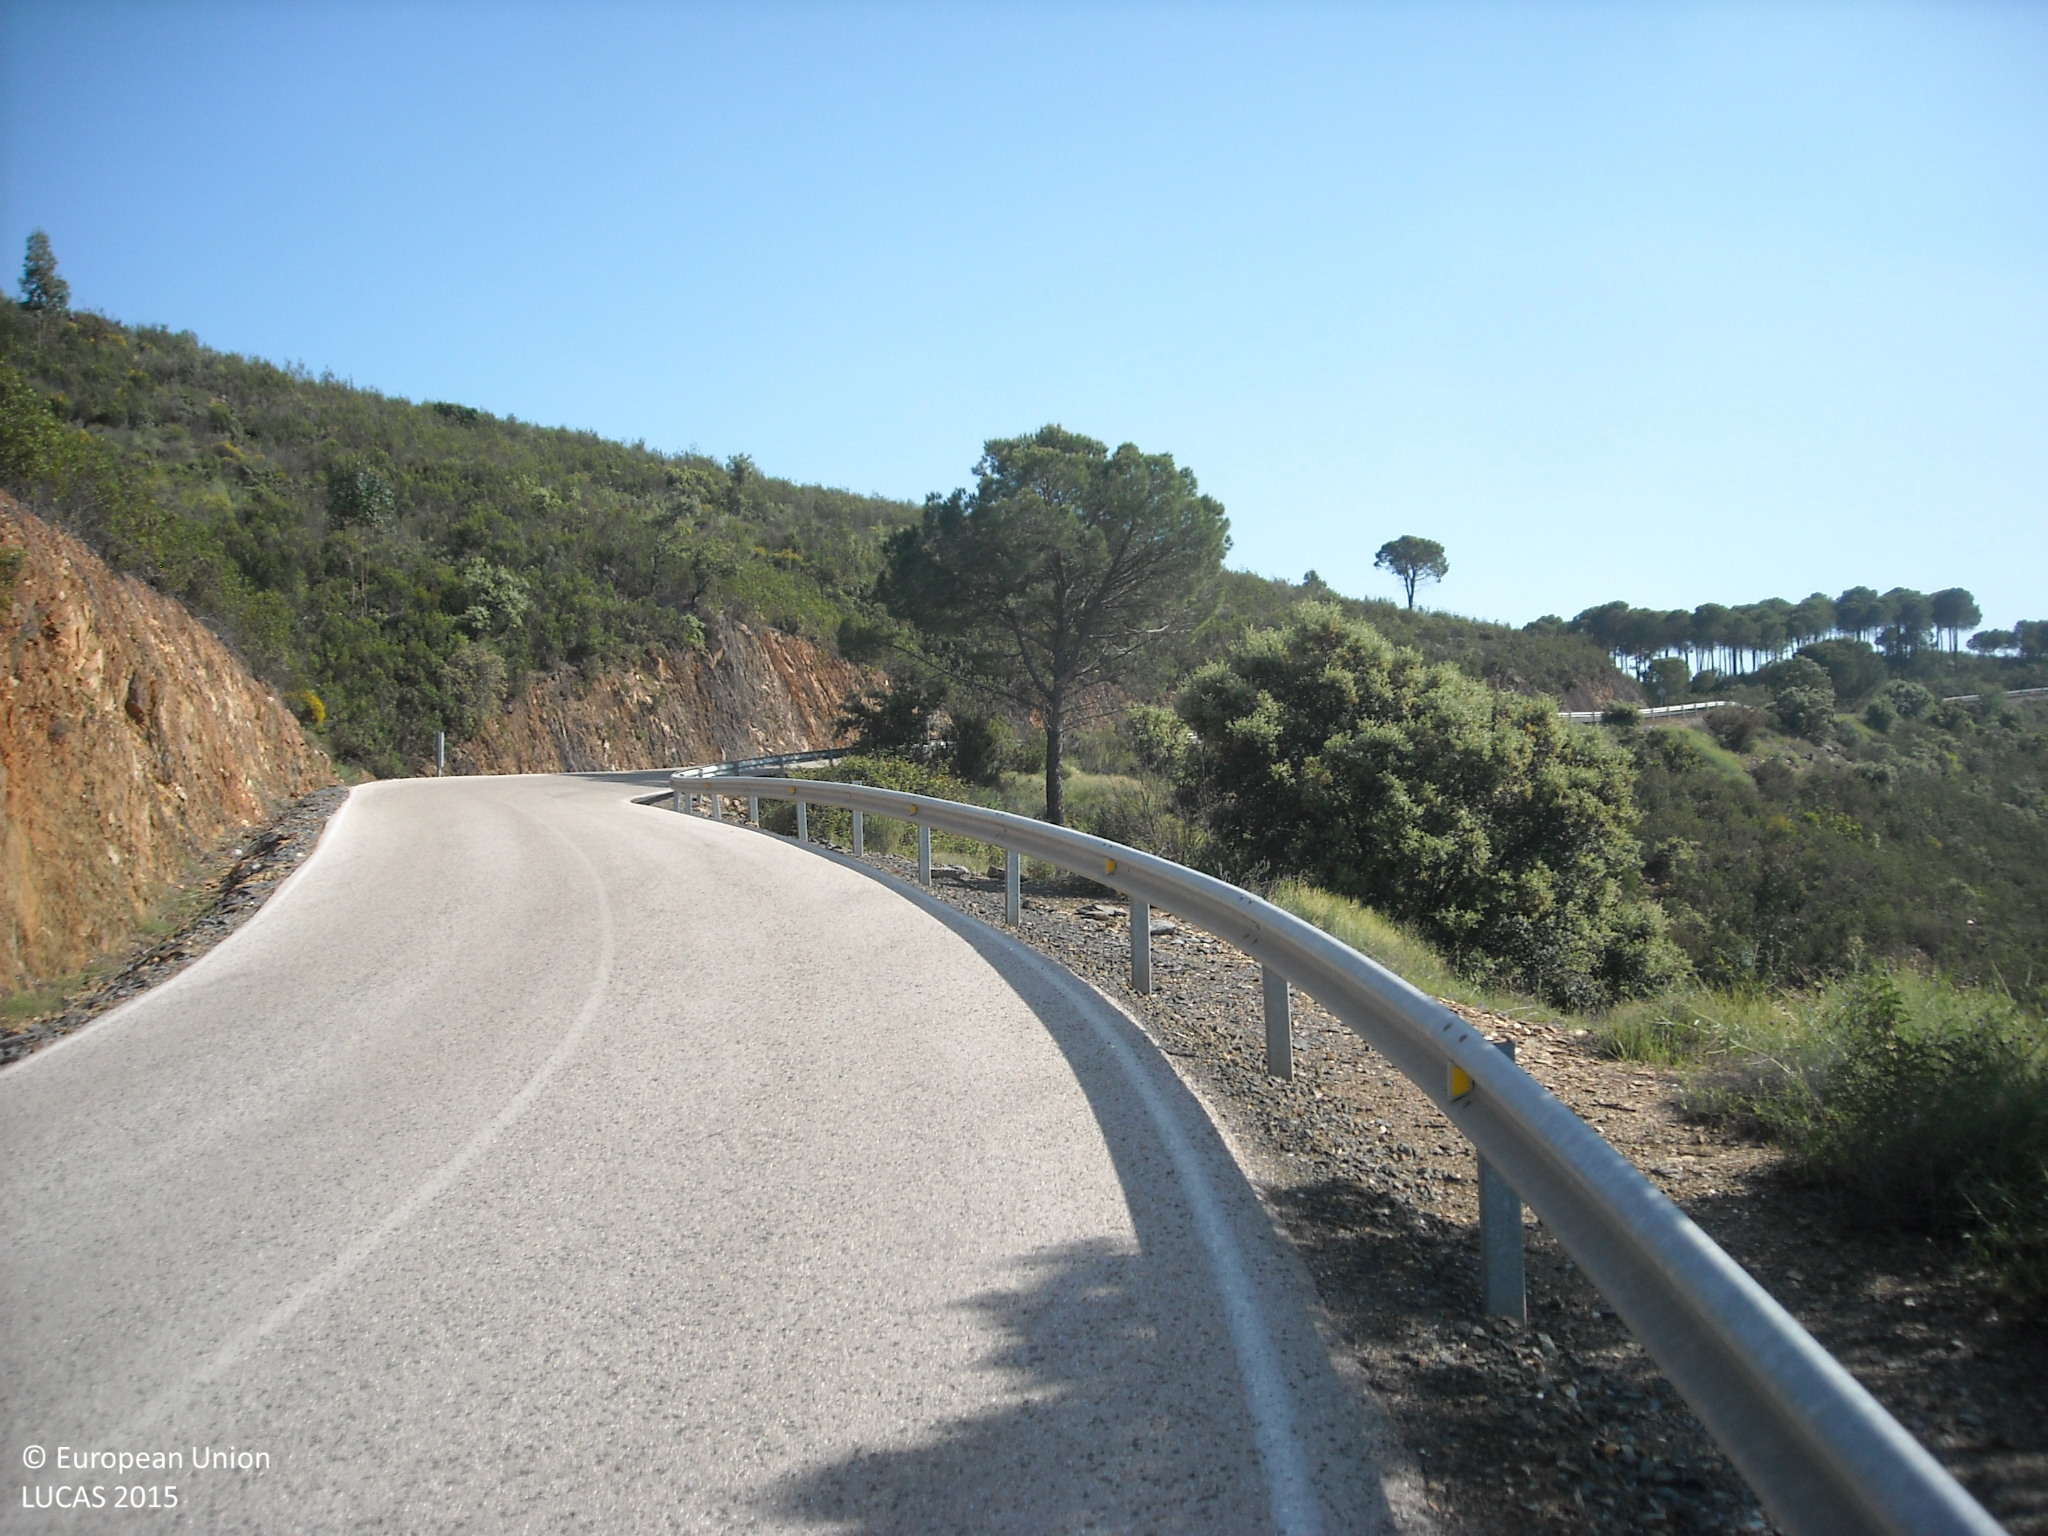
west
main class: Shrubland
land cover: Shrubland without tree cover
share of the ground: > 75 %
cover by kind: shrubs 75 %, herbaceous plants 25 %
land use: Semi-natural and natural areas not in use
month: April
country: ES
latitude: 37.6458
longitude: -6.4822
